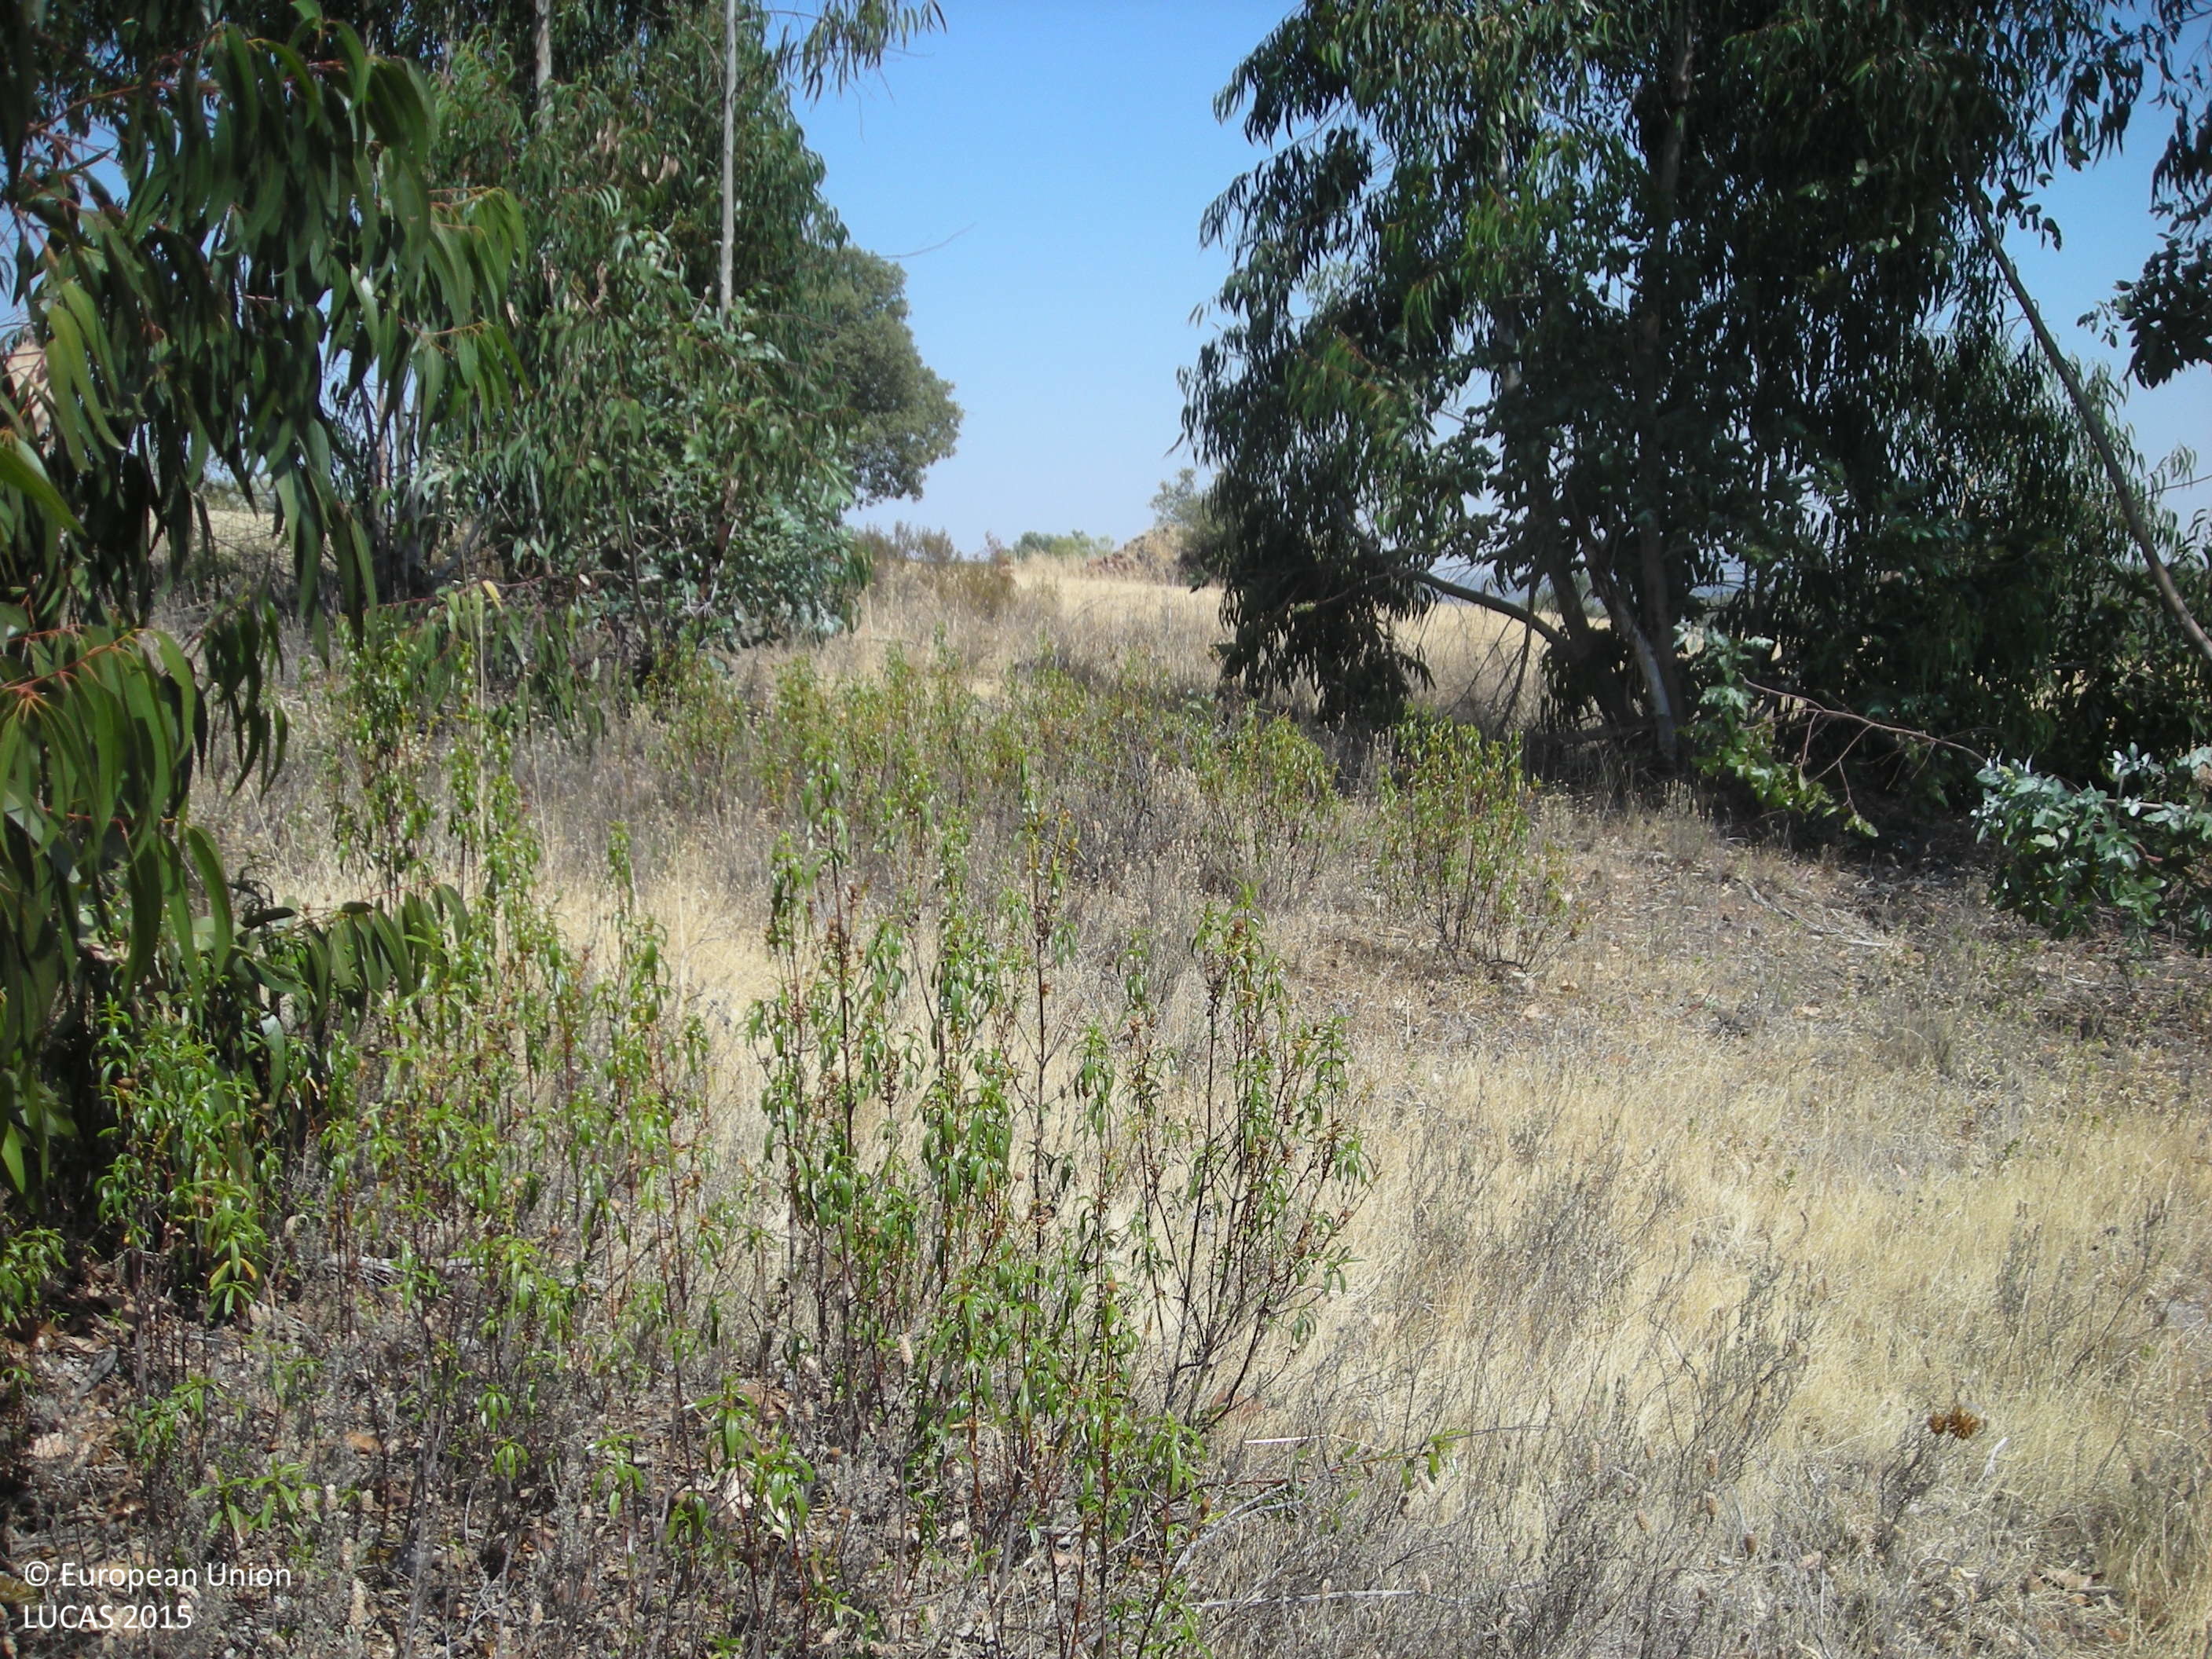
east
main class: Shrubland
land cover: Shrubland with sparse tree cover
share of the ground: > 75 %
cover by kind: shrubs 95 %, broadleaved forest trees 5 %
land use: Semi-natural and natural areas not in use
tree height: > 5 m
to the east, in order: Shrubland with sparse tree cover; Broadleaved woodland
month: June
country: ES
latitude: 38.5794
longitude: -5.8726
